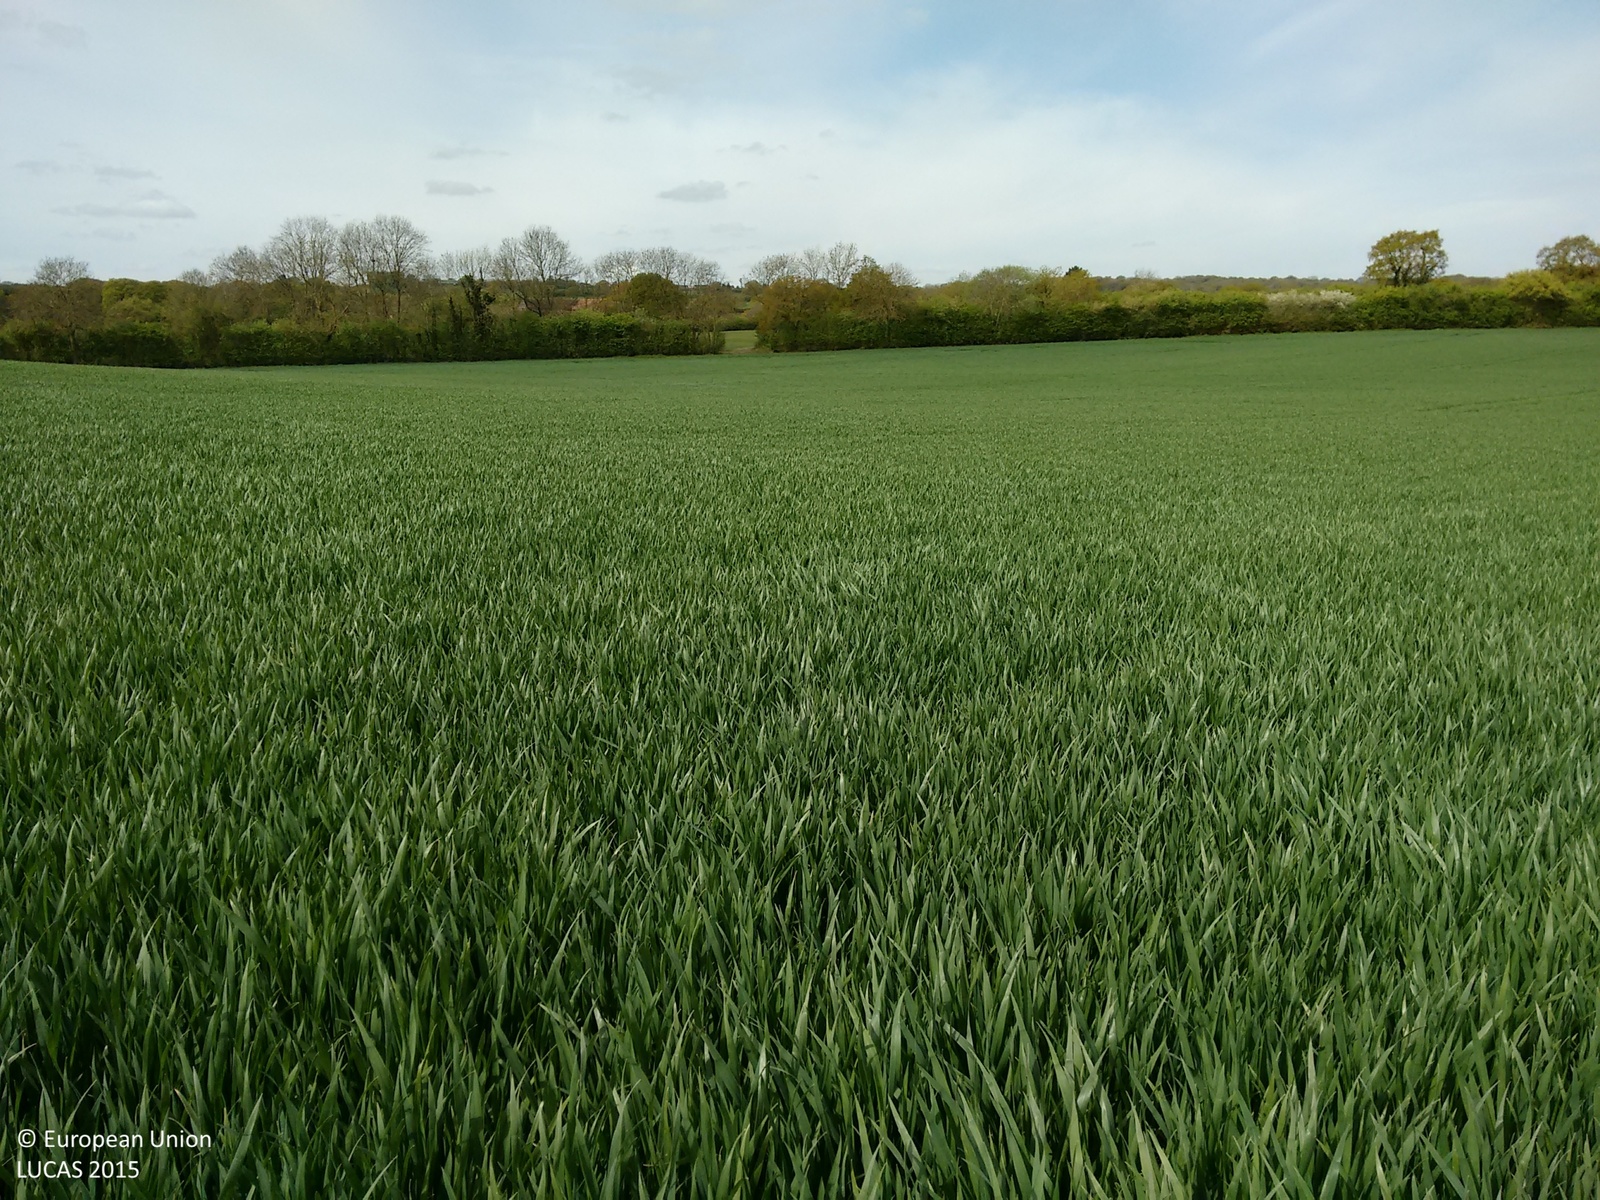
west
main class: Cropland
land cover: Common wheat
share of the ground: > 75 %
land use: Agriculture (excluding fallow land and kitchen gardens)
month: May
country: GB
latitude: 52.2660
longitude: -1.9113
